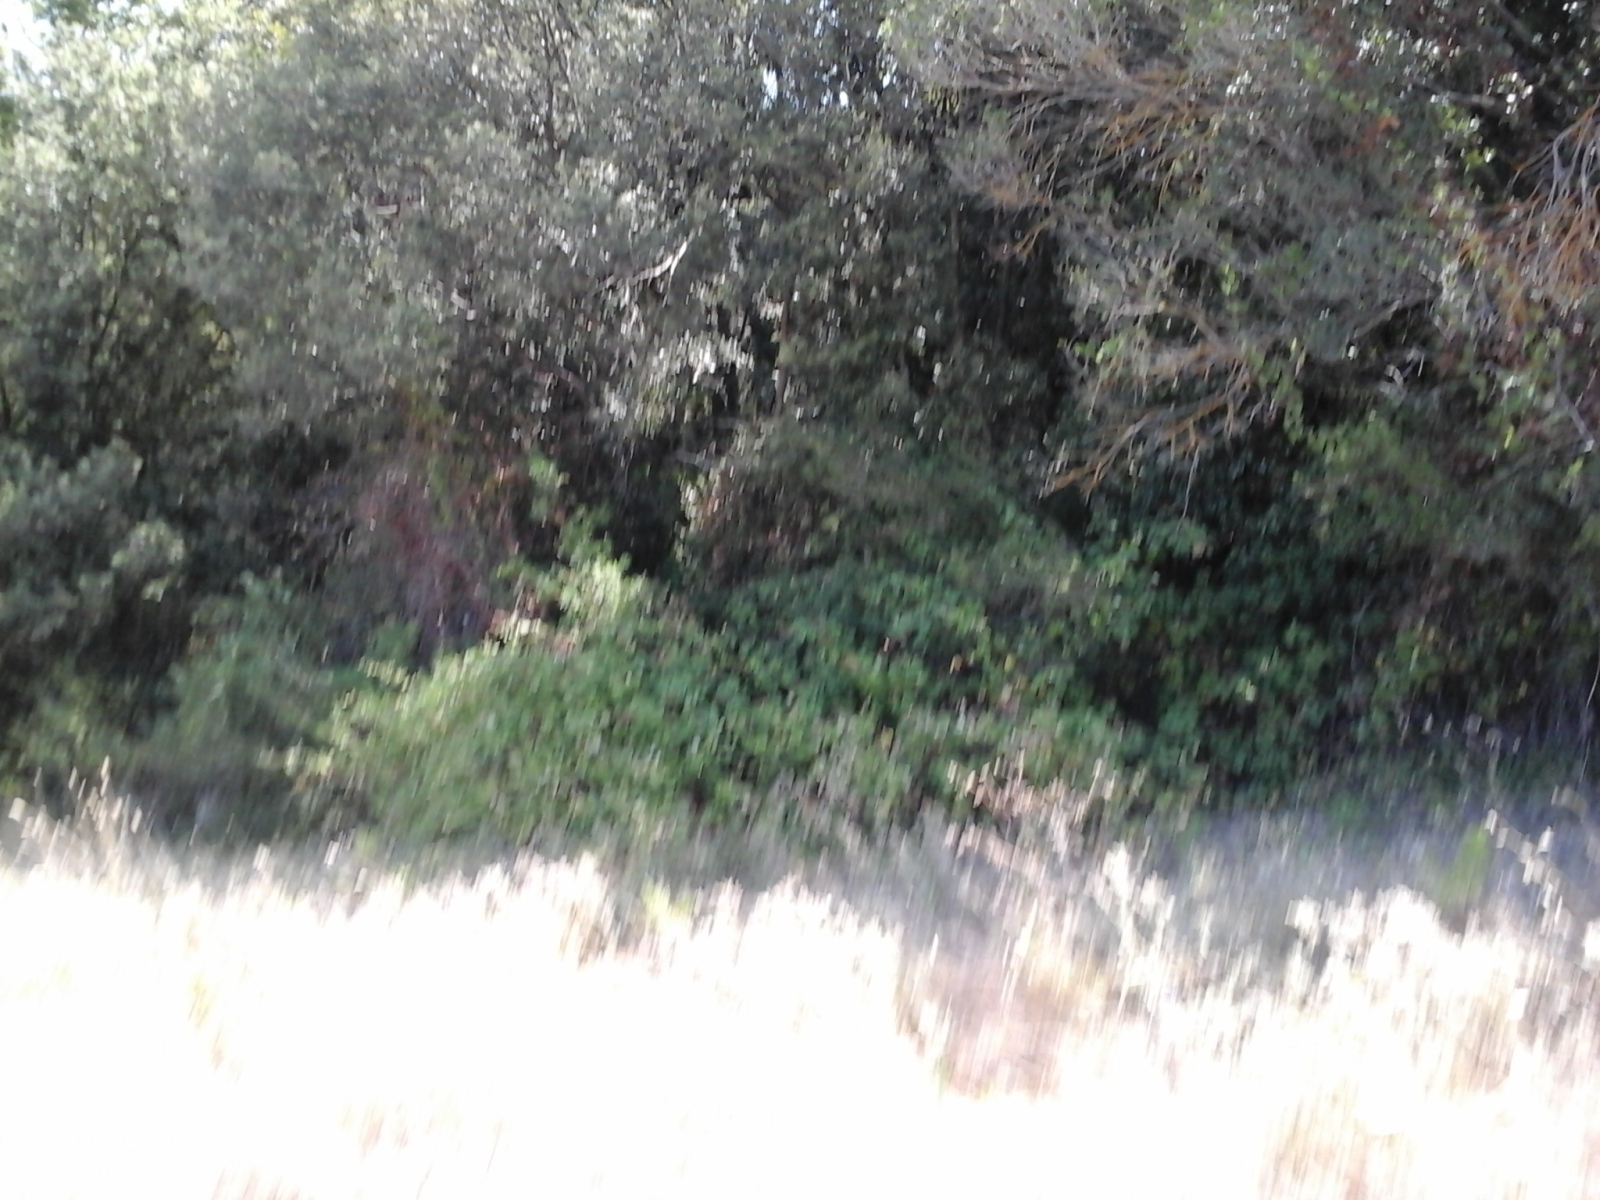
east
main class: Grassland
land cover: Grassland without tree/shrub cover
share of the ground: 50 - 75 %
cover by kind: herbaceous plants 95 %, unconsolidated bare surface 5 %
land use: Agriculture (excluding fallow land and kitchen gardens)
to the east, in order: Grassland without tree/shrub cover; Groves; Broadleaved woodland; Rocks and stones; Broadleaved woodland; Grassland without tree/shrub cover
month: July
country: IT
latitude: 42.9849
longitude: 11.5771
